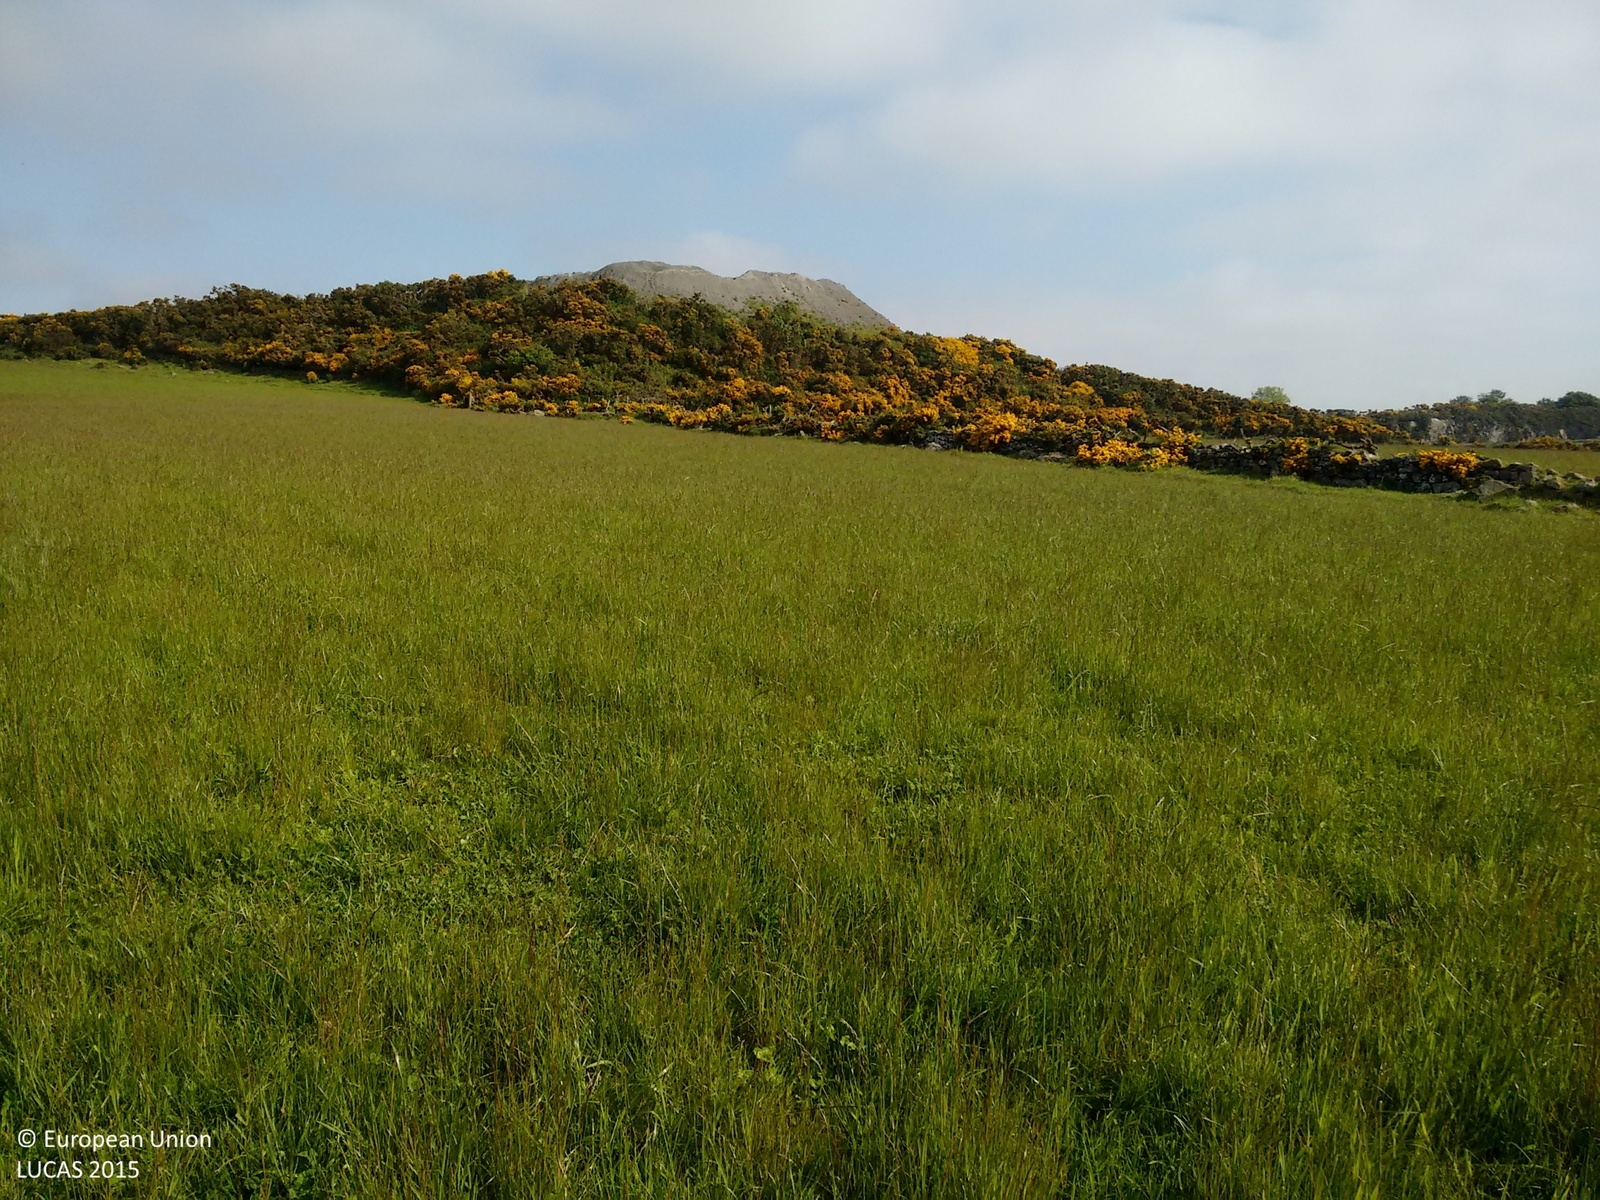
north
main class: Grassland
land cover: Grassland without tree/shrub cover
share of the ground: > 75 %
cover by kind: herbaceous plants 100 %
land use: Agriculture (excluding fallow land and kitchen gardens)
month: June
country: GB
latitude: 57.2516
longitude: -2.0975
